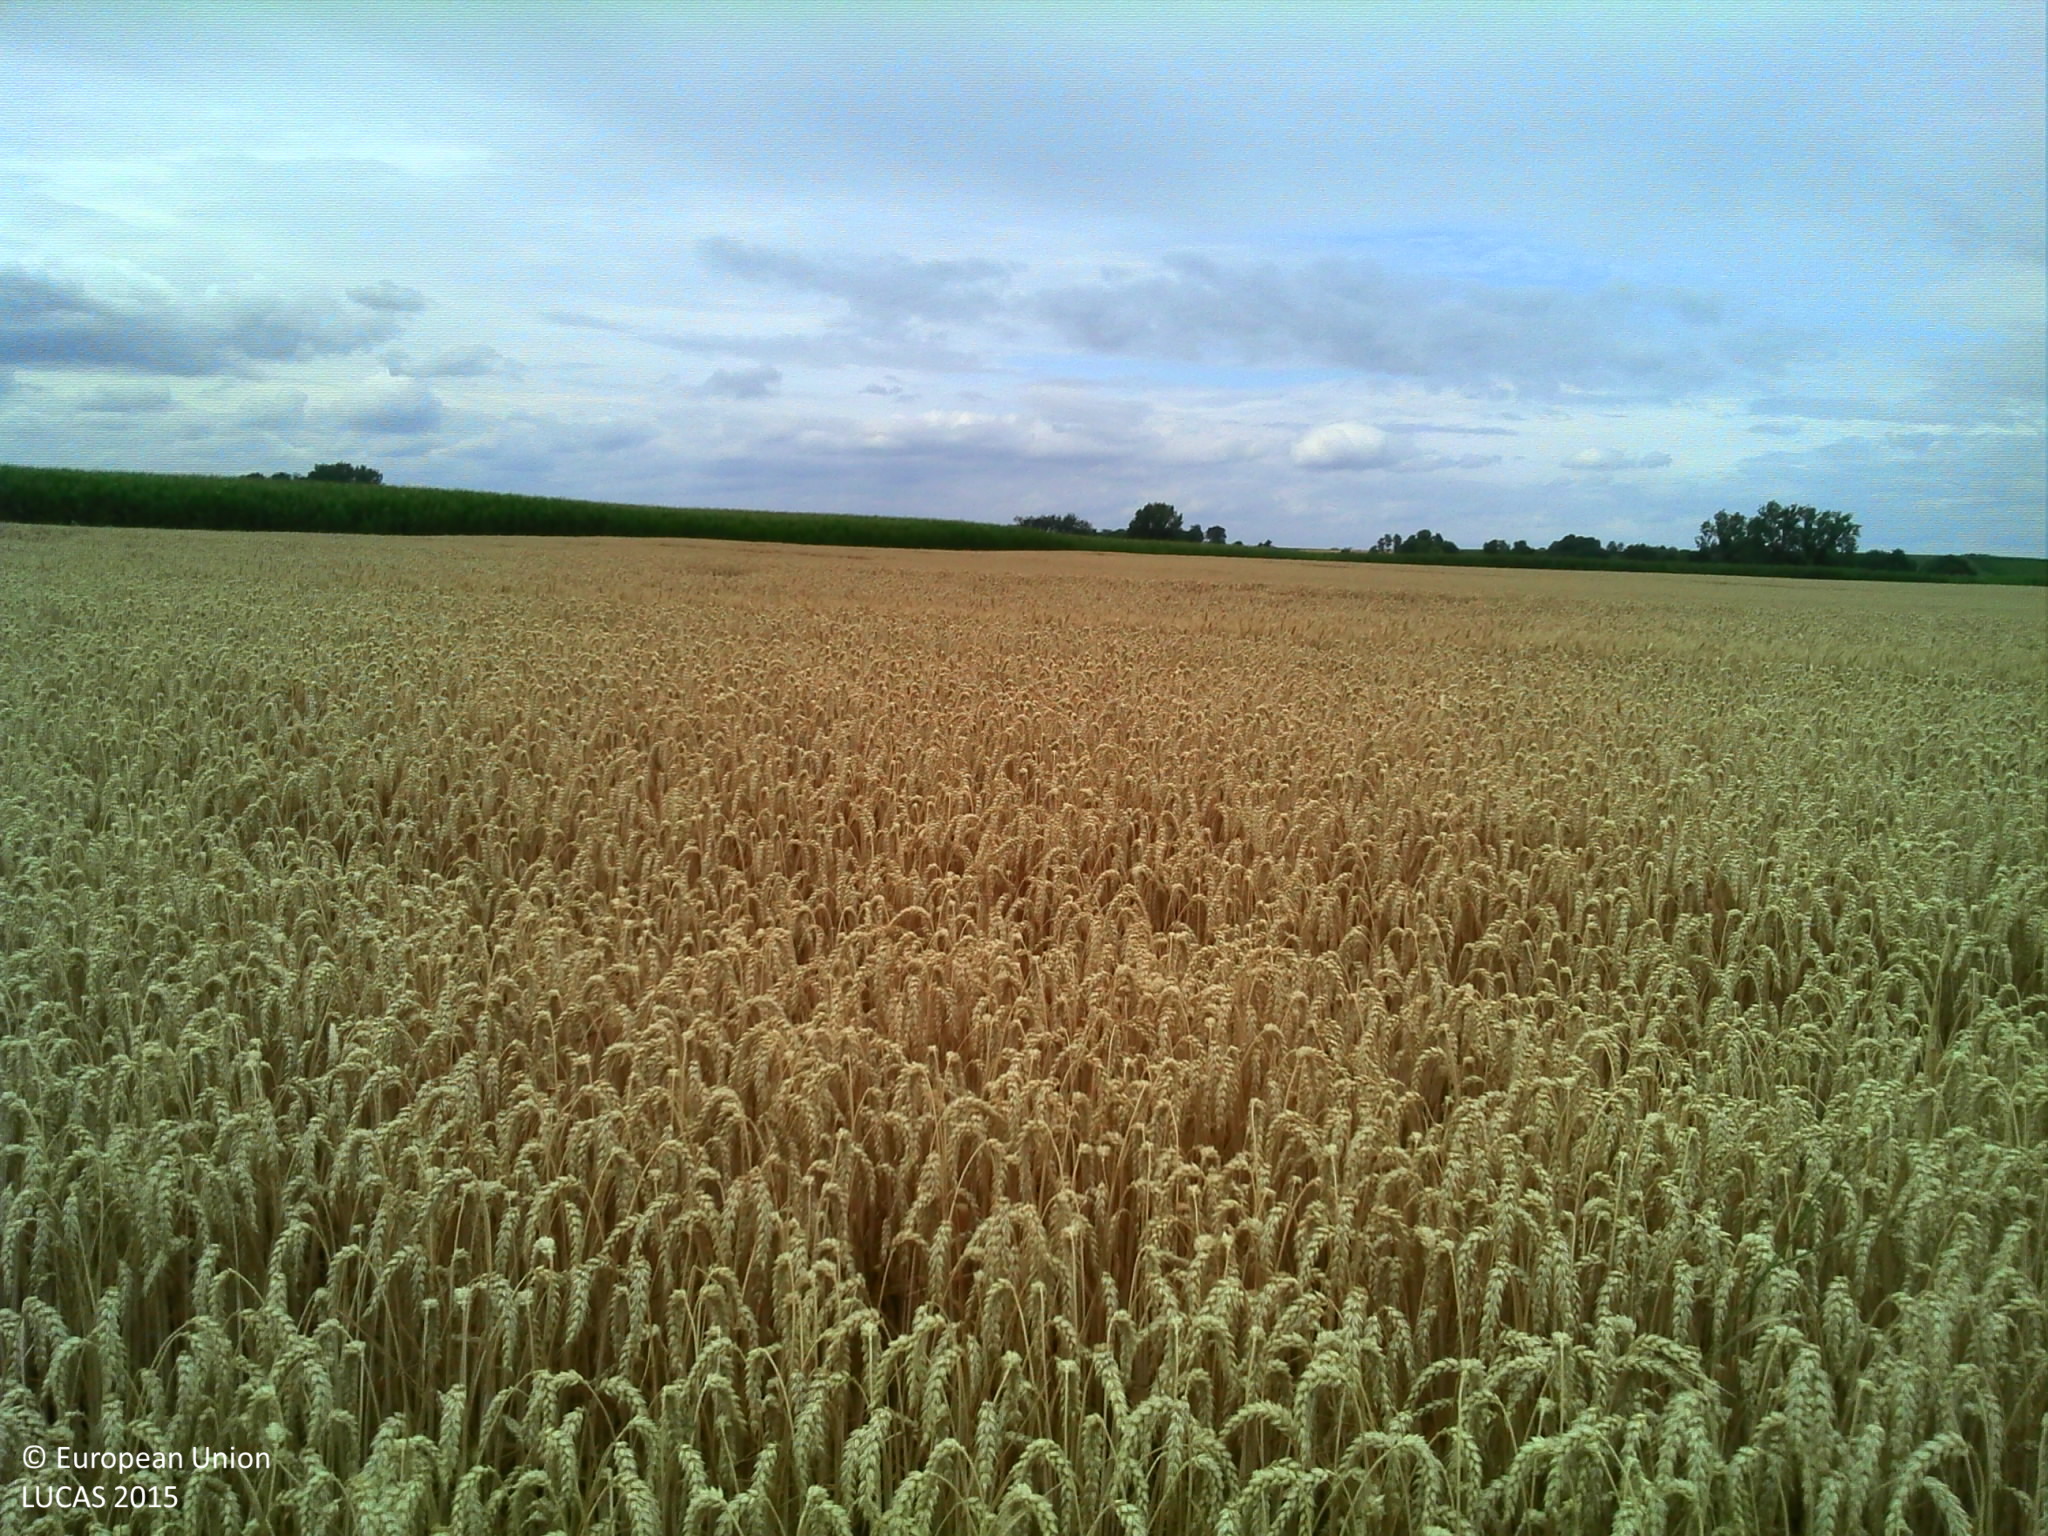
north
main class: Cropland
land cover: Common wheat
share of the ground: > 75 %
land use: Agriculture (excluding fallow land and kitchen gardens)
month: July
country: FR
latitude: 48.6660
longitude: 7.6246
